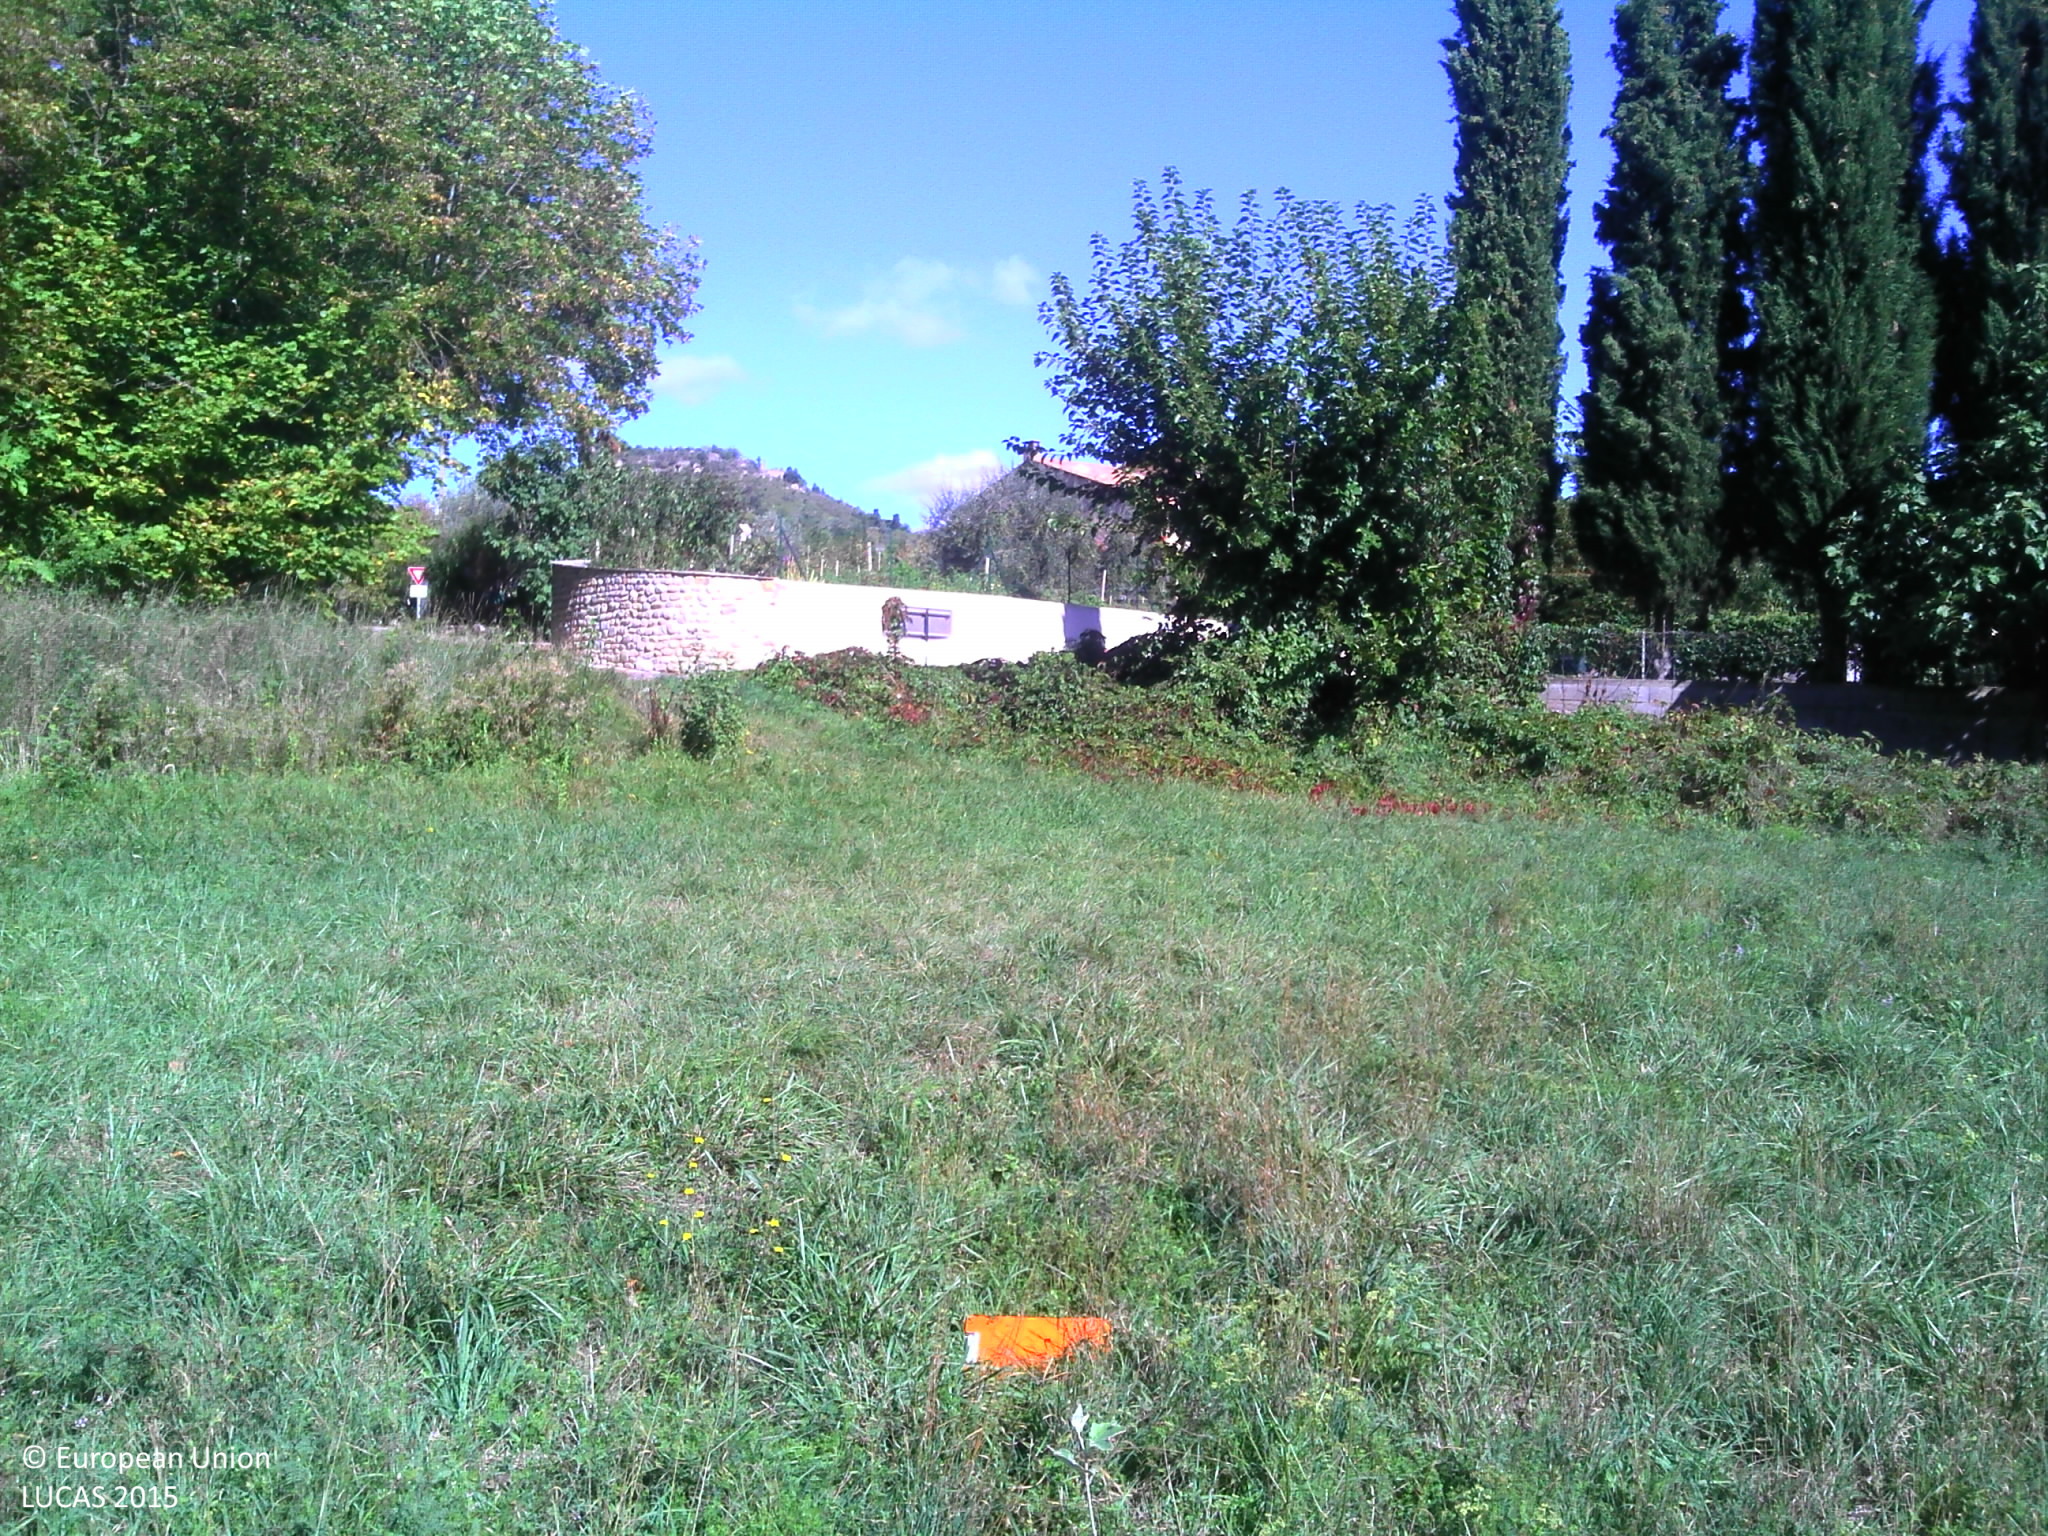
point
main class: Grassland
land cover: Grassland without tree/shrub cover
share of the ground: > 75 %
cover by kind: herbaceous plants 100 %
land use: Agriculture (excluding fallow land and kitchen gardens)
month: November
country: FR
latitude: 44.4020
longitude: 5.1983
